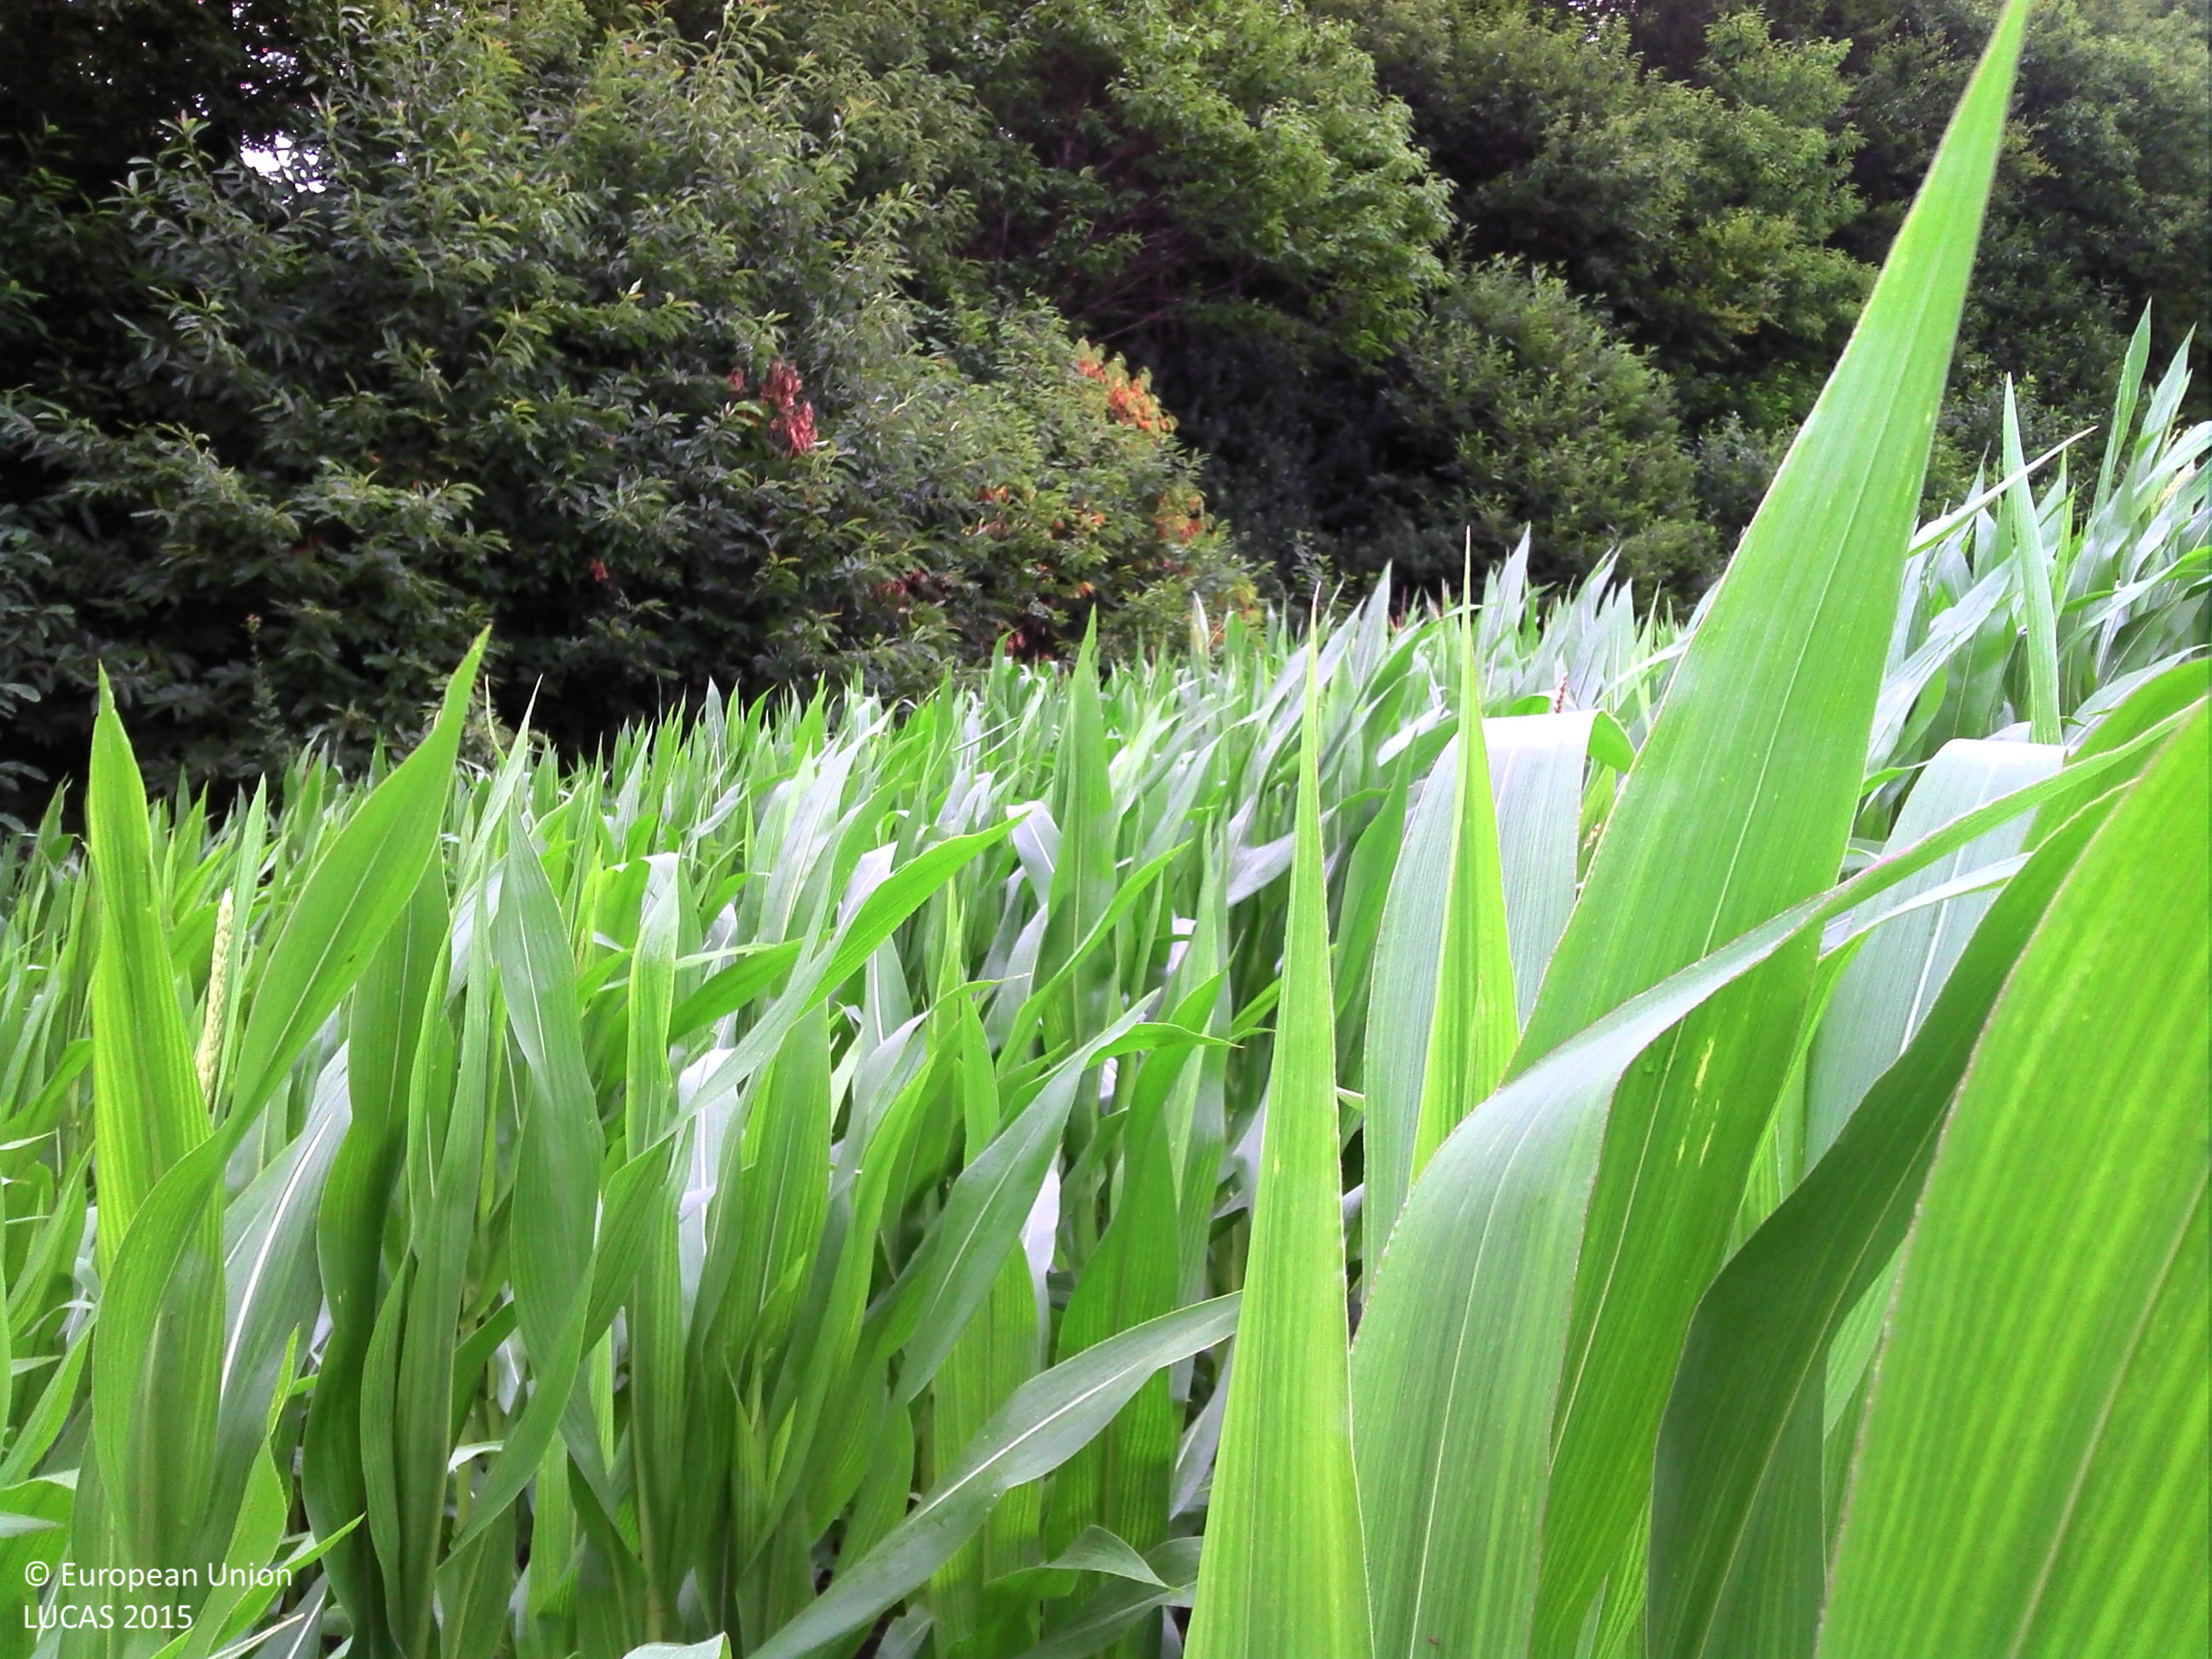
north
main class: Cropland
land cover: Maize
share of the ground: > 75 %
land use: Agriculture (excluding fallow land and kitchen gardens)
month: July
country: FR
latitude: 48.0027
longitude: -3.5478
